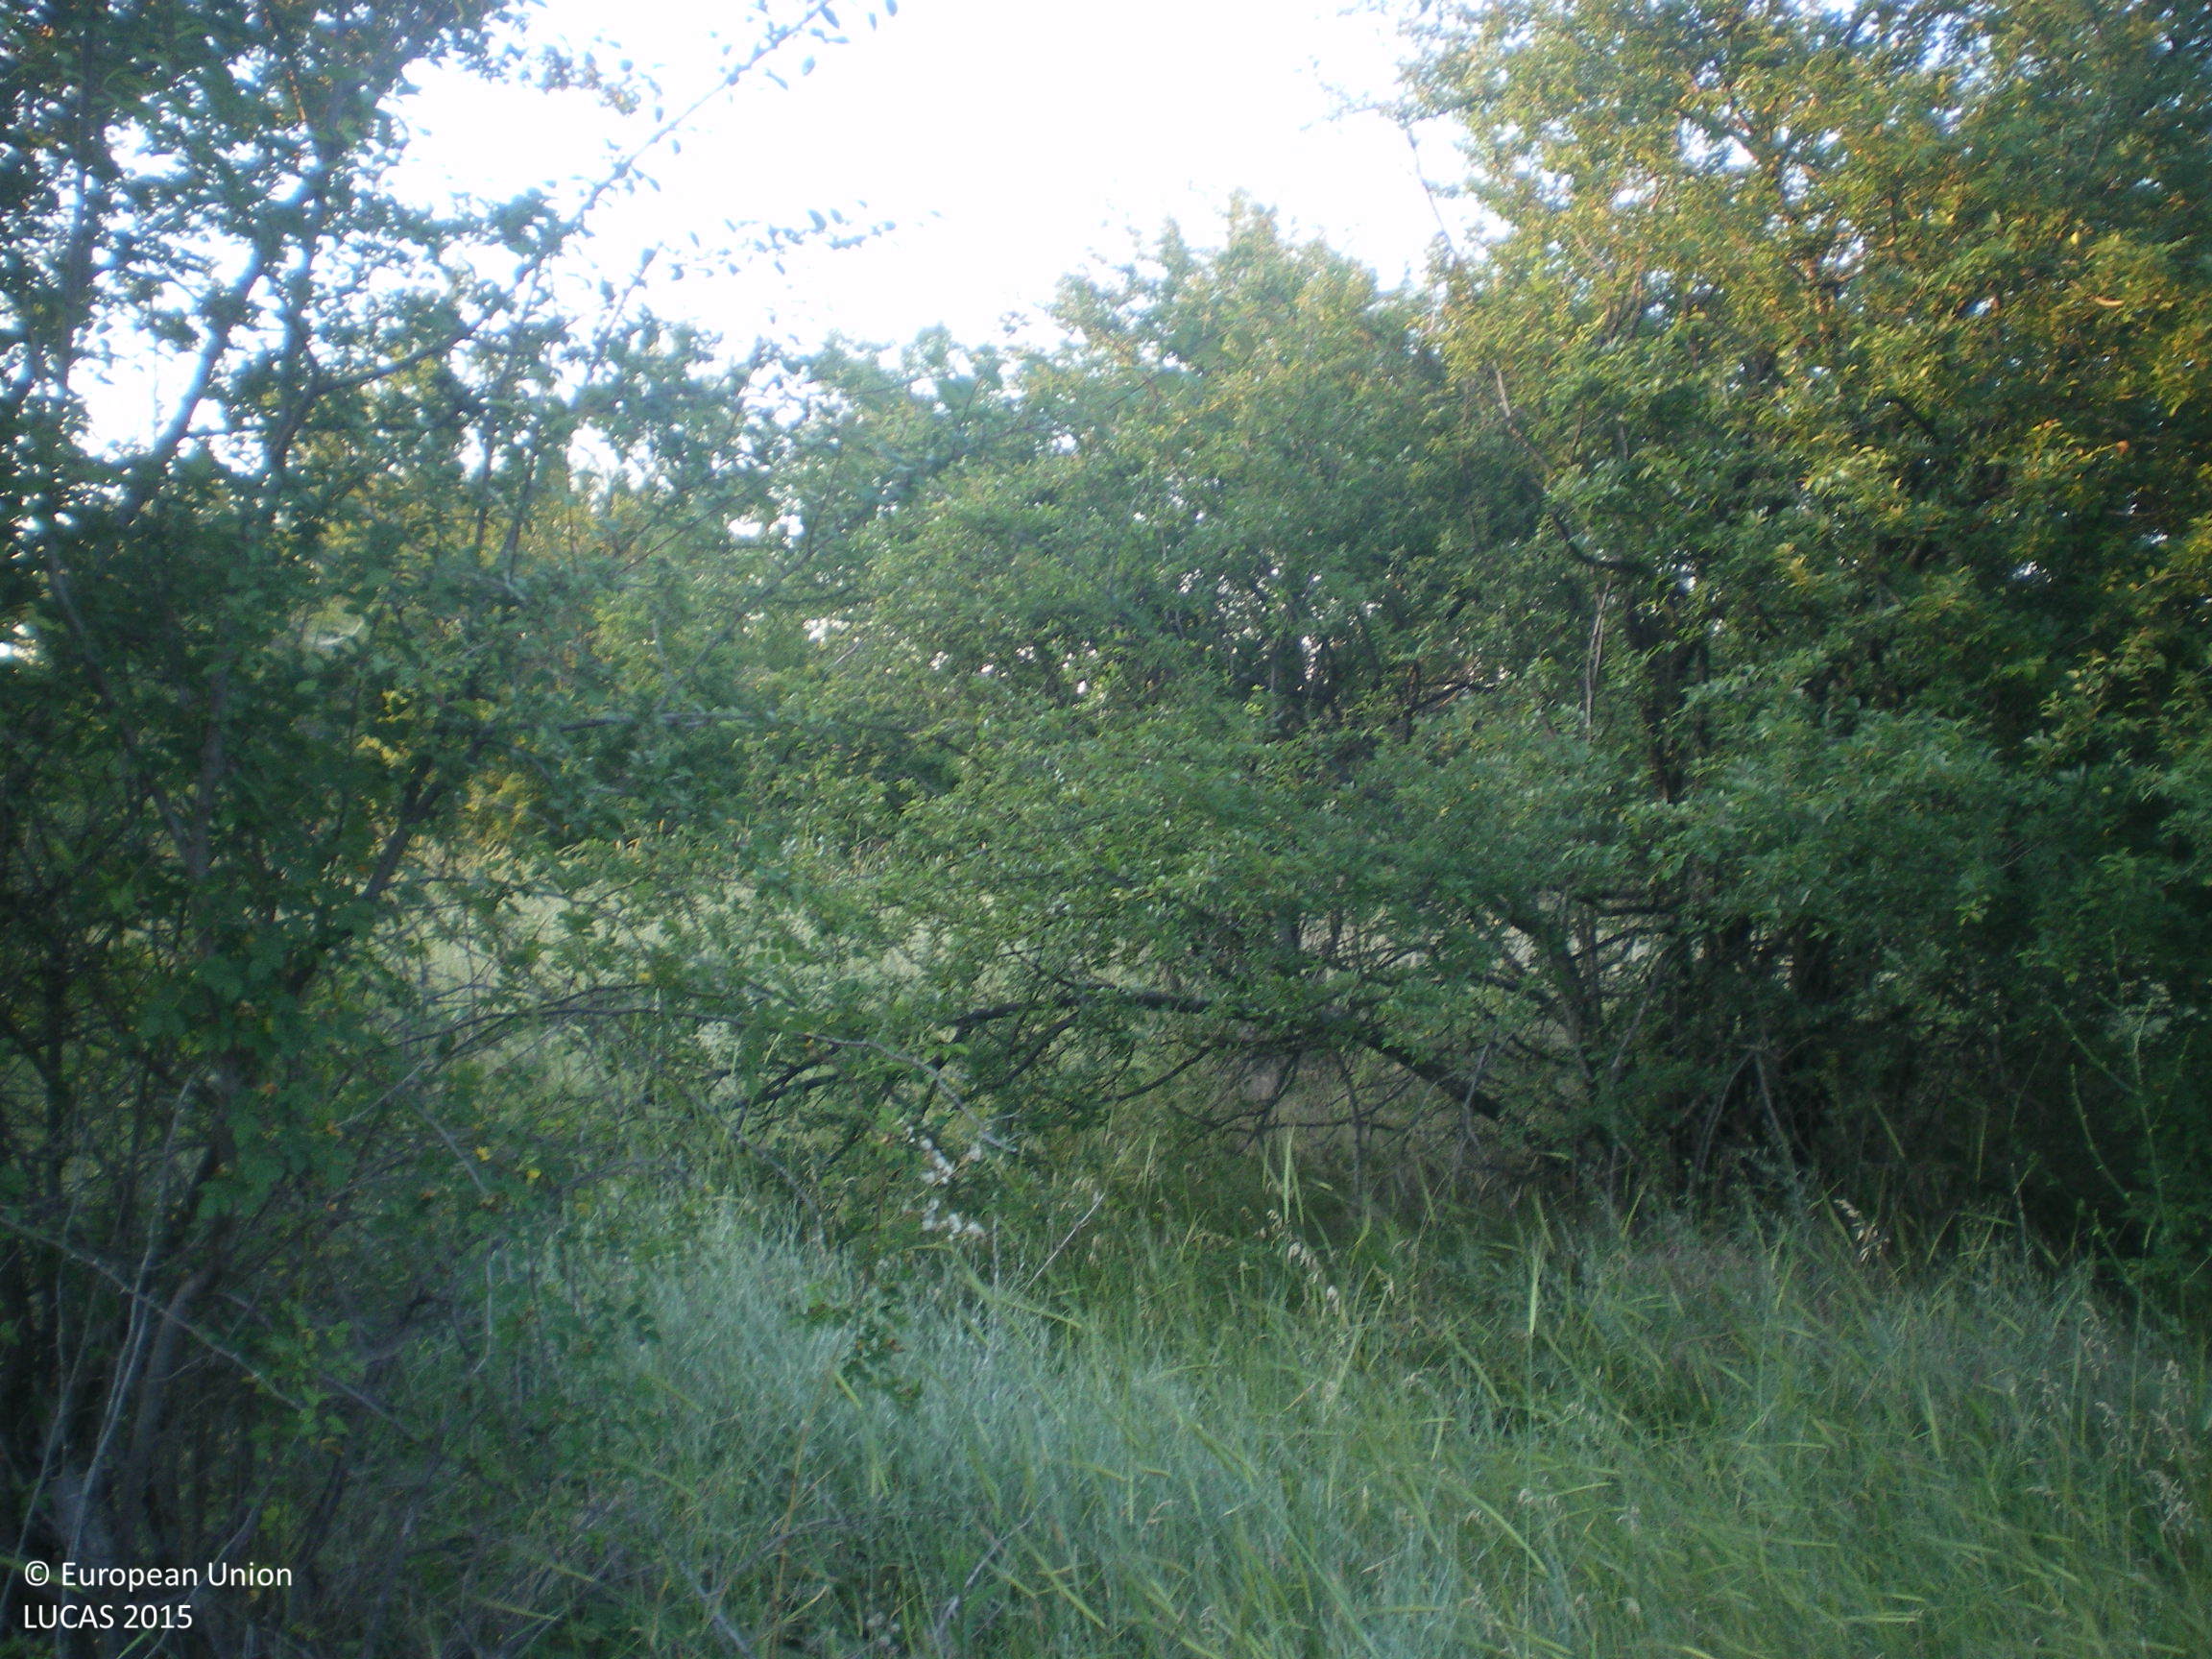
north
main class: Woodland
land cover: Broadleaved woodland
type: mesophytic deciduous forest
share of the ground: 25 - 50 %
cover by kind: broadleaved forest trees 50 %, herbaceous plants 35 %, shrubs 15 %
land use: Semi-natural and natural areas not in use
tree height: > 5 m
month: June
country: BG
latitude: 42.3857
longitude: 25.1600
